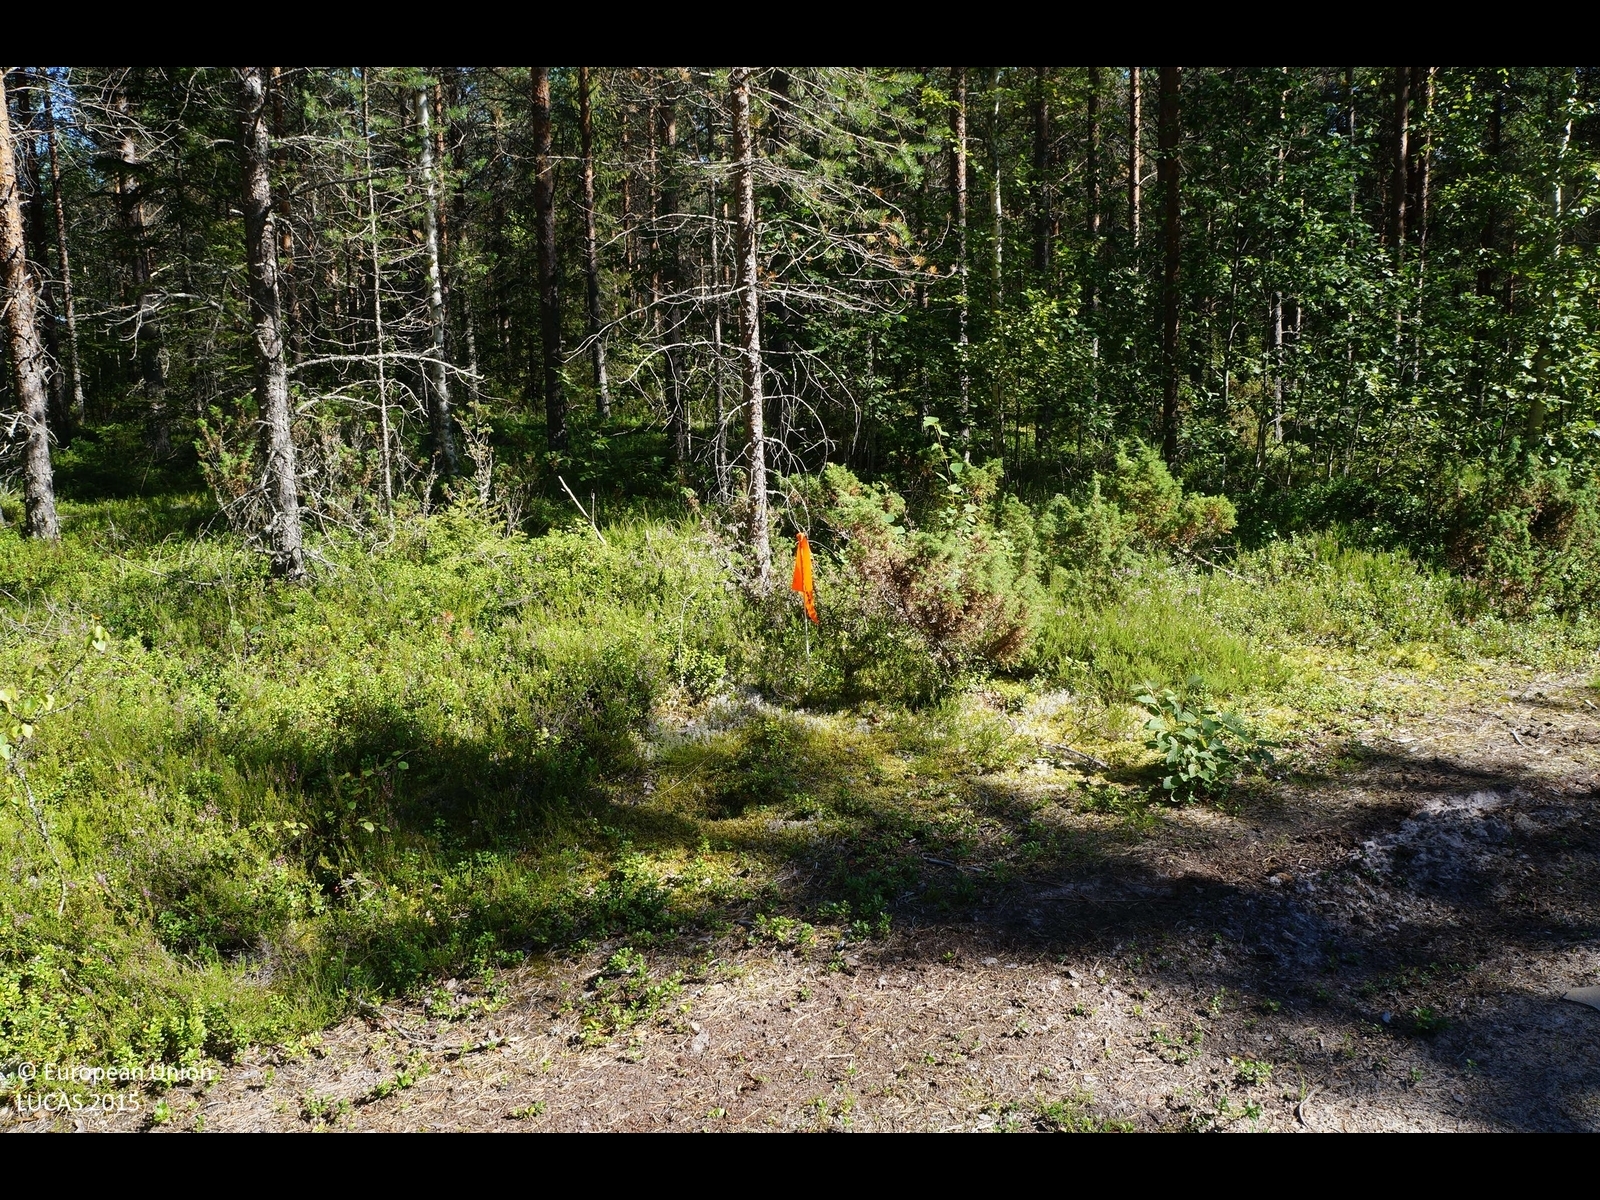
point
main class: Woodland
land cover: Pine dominated coniferous woodland
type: boreal forest
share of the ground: 50 - 75 %
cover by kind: coniferous forest trees 60 %, shrubs 30 %, lichens and mosses 10 %
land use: Forestry
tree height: > 5 m
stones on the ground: < 10 %
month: August
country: FI
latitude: 64.5961
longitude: 24.6748
